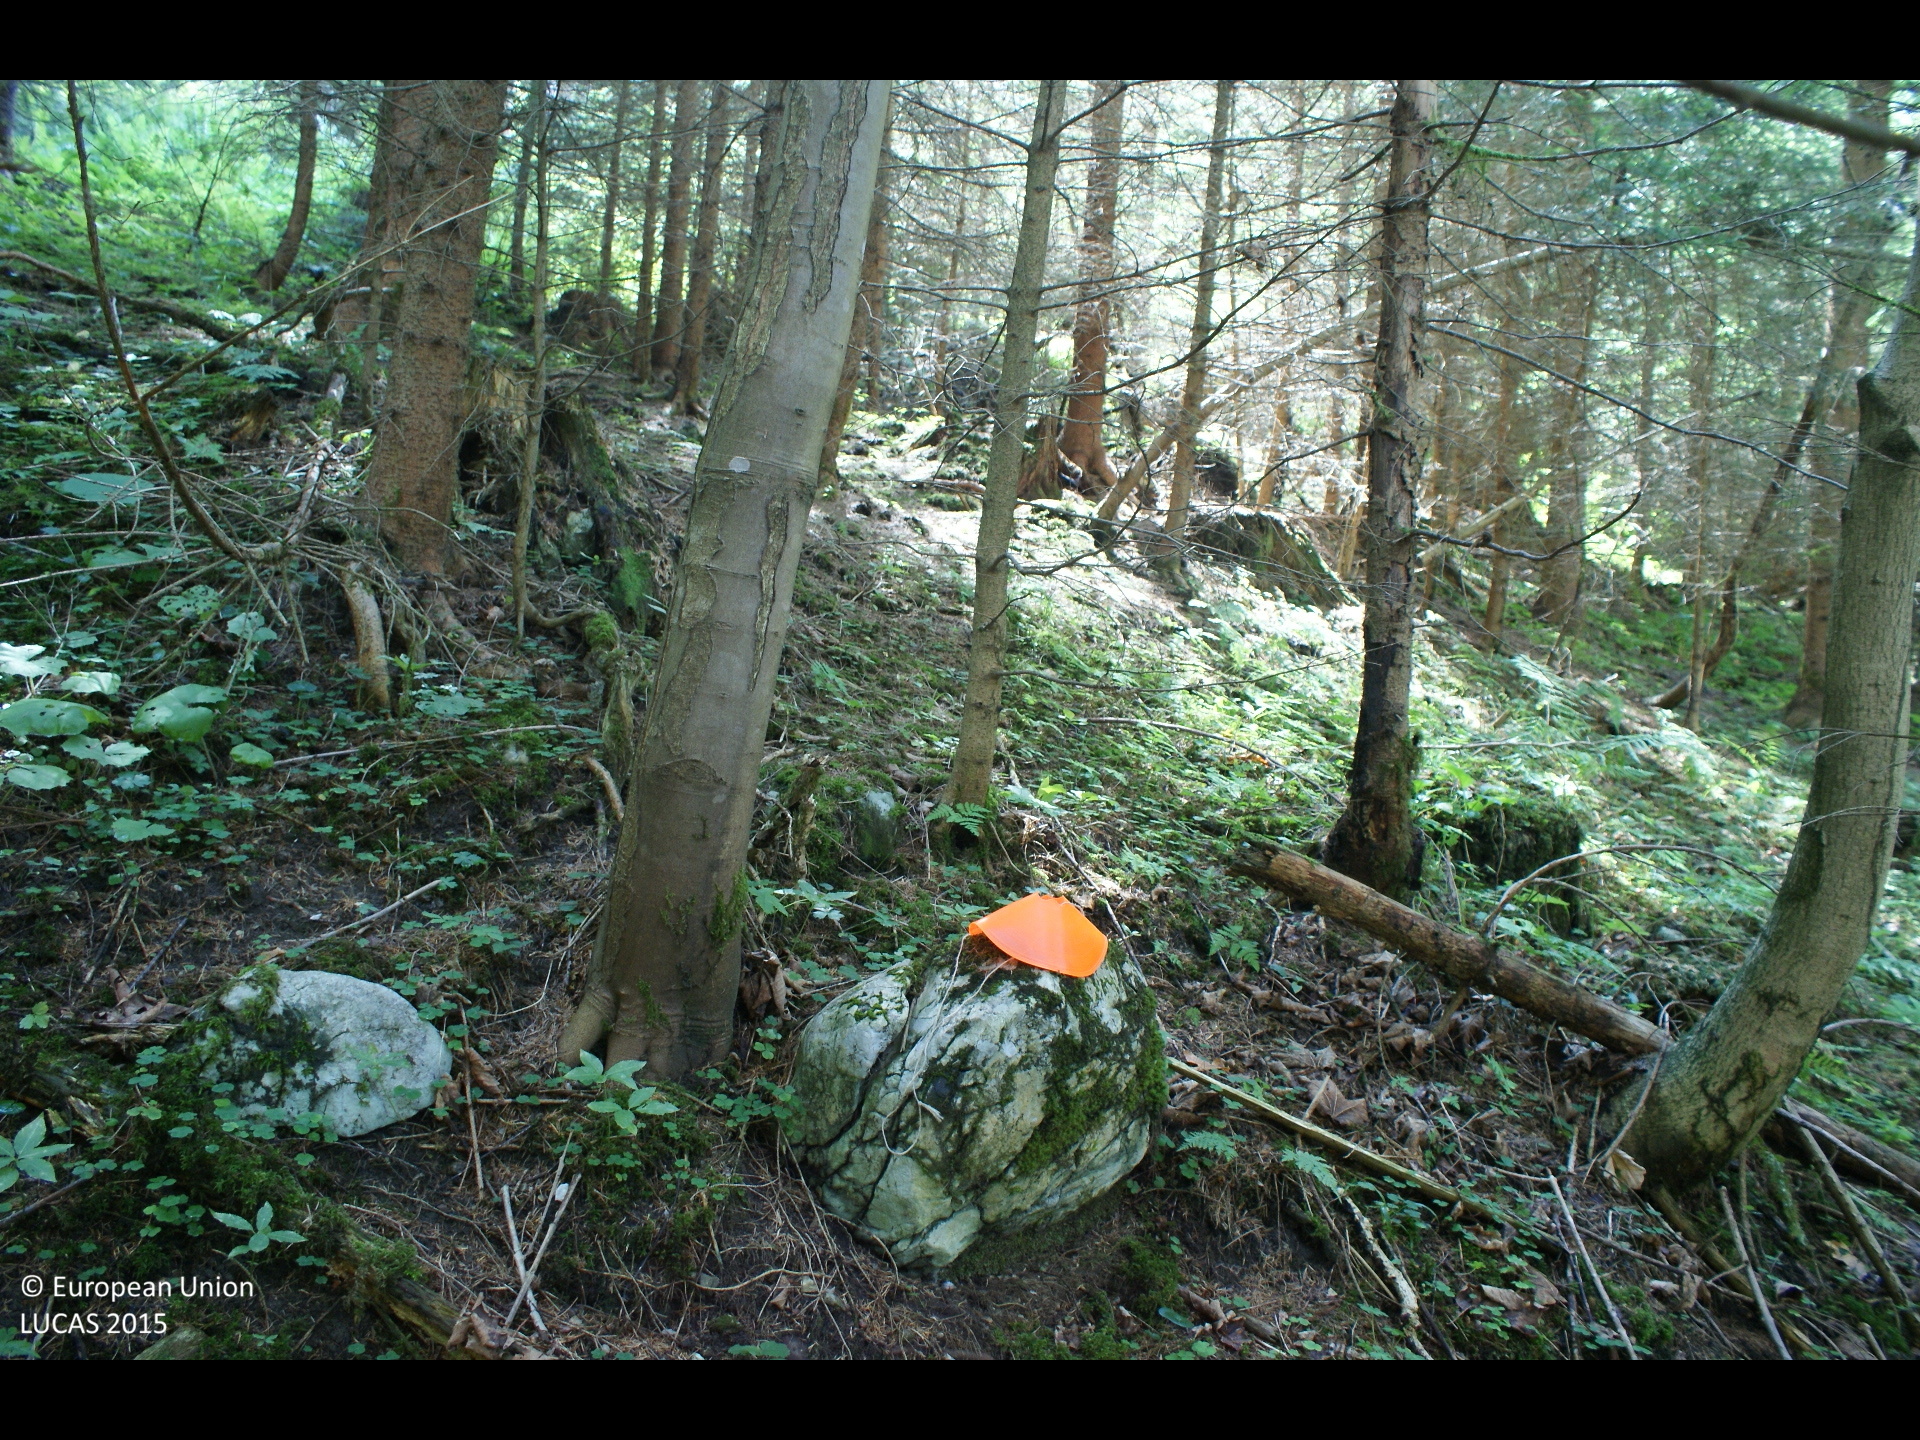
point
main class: Woodland
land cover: Spruce dominated mixed woodland
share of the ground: > 75 %
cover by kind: coniferous forest trees 65 %, broadleaved forest trees 25 %, herbaceous plants 5 %, lichens and mosses 5 %
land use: Forestry
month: July
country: AT
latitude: 47.7937
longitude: 14.8194
